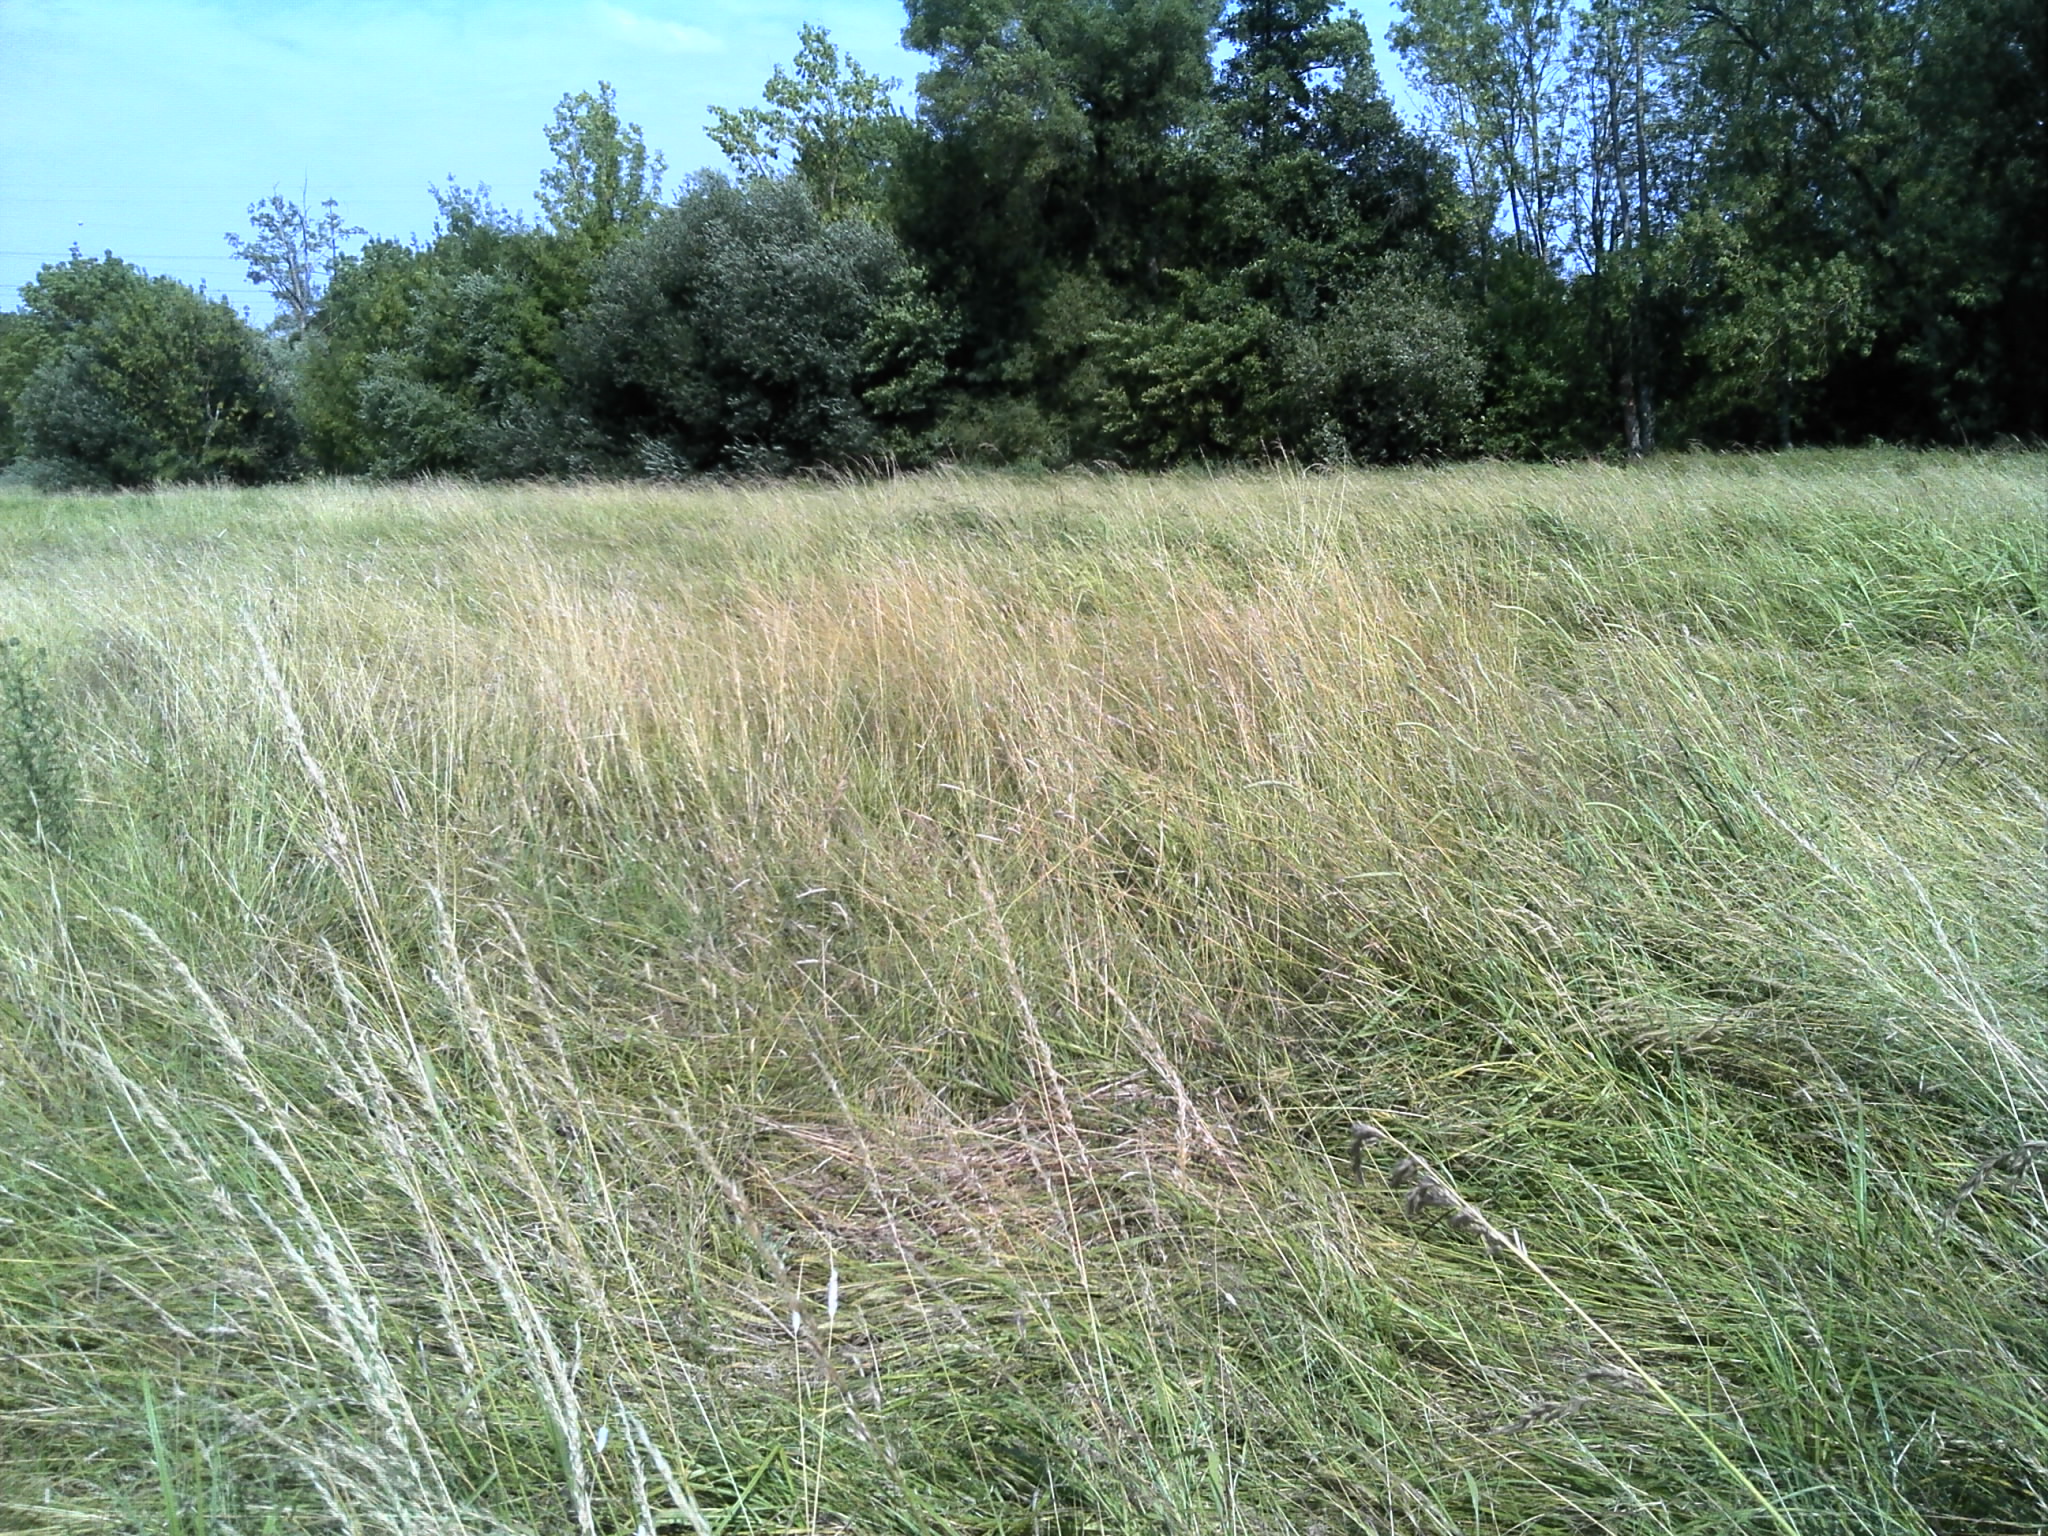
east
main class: Grassland
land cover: Grassland without tree/shrub cover
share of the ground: > 75 %
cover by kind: herbaceous plants 100 %
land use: Agriculture (excluding fallow land and kitchen gardens)
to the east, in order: Grassland without tree/shrub cover; Ditches and canals; Fences; Broadleaved woodland; Inland fresh water bodies; Broadleaved woodland; Tracks; Broadleaved woodland; Tracks; Grassland without tree/shrub cover; Electric lines; Grassland without tree/shrub cover; Broadleaved woodland; Inland fresh water bodies; Electric lines; Broadleaved woodland; Inland fresh water bodies
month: July
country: FR
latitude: 46.8021
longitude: 1.6429
